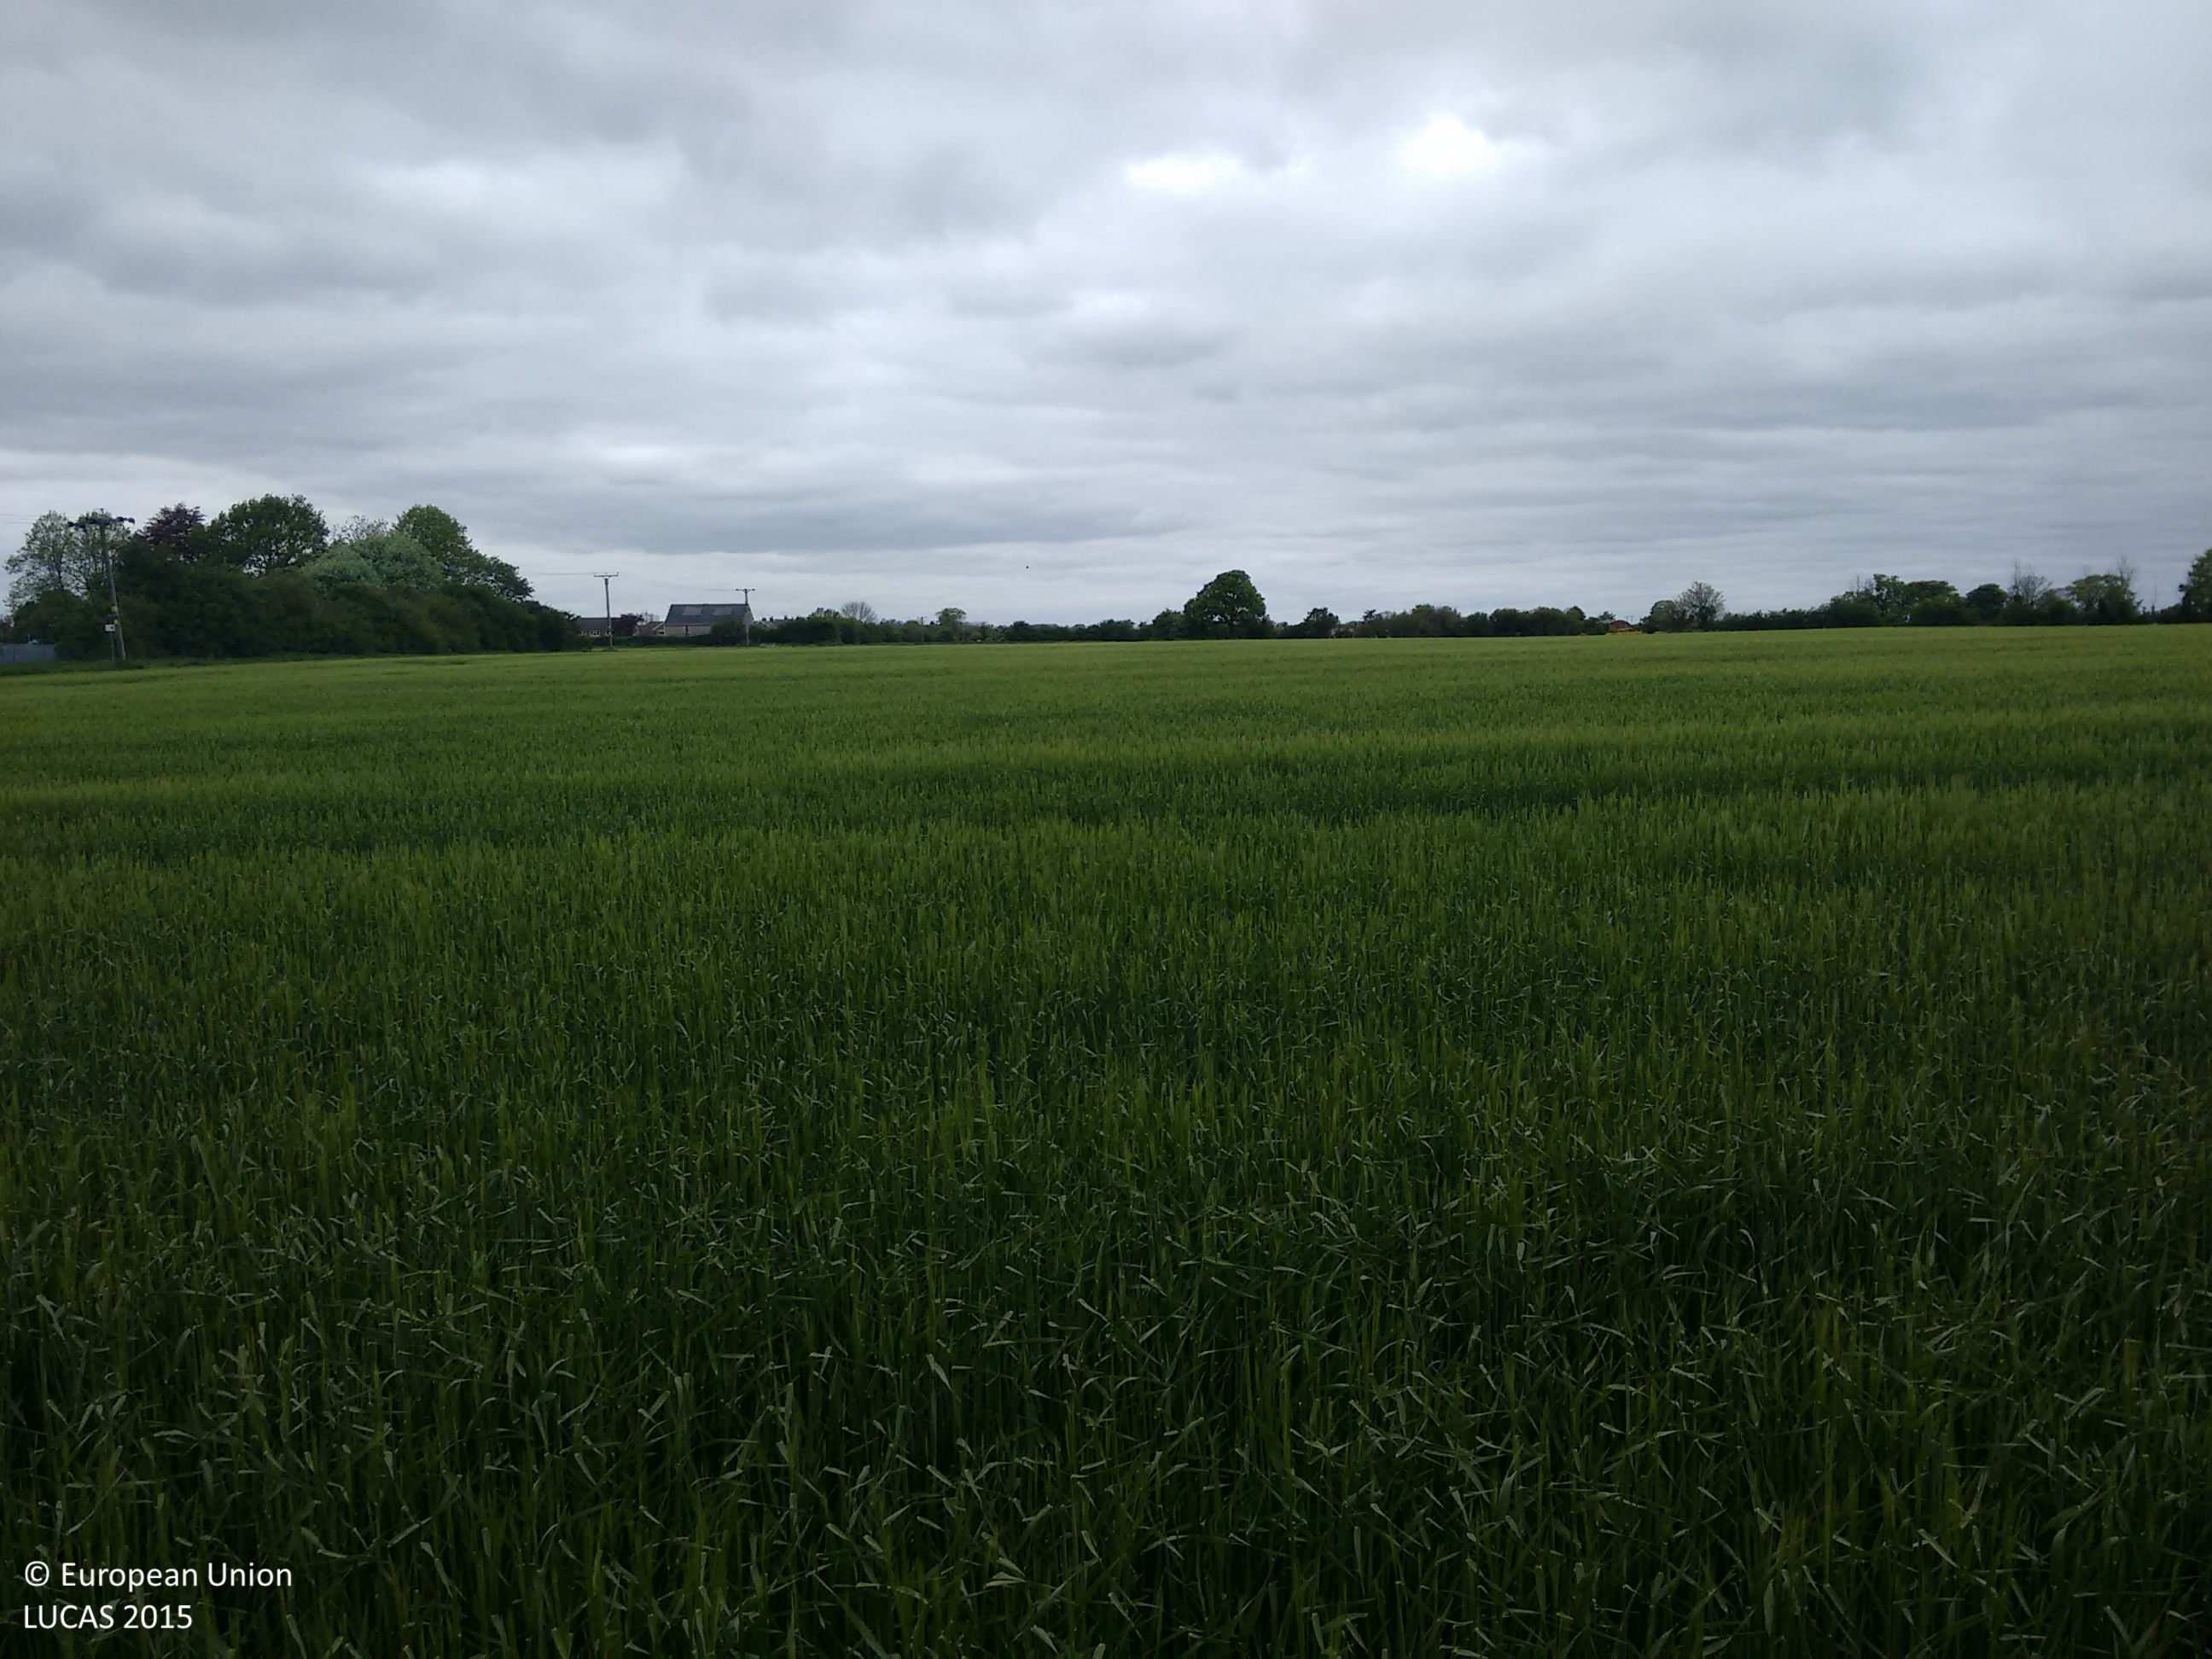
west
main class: Cropland
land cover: Barley
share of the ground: > 75 %
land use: Agriculture (excluding fallow land and kitchen gardens)
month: May
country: GB
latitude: 53.7818
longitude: -0.2477
